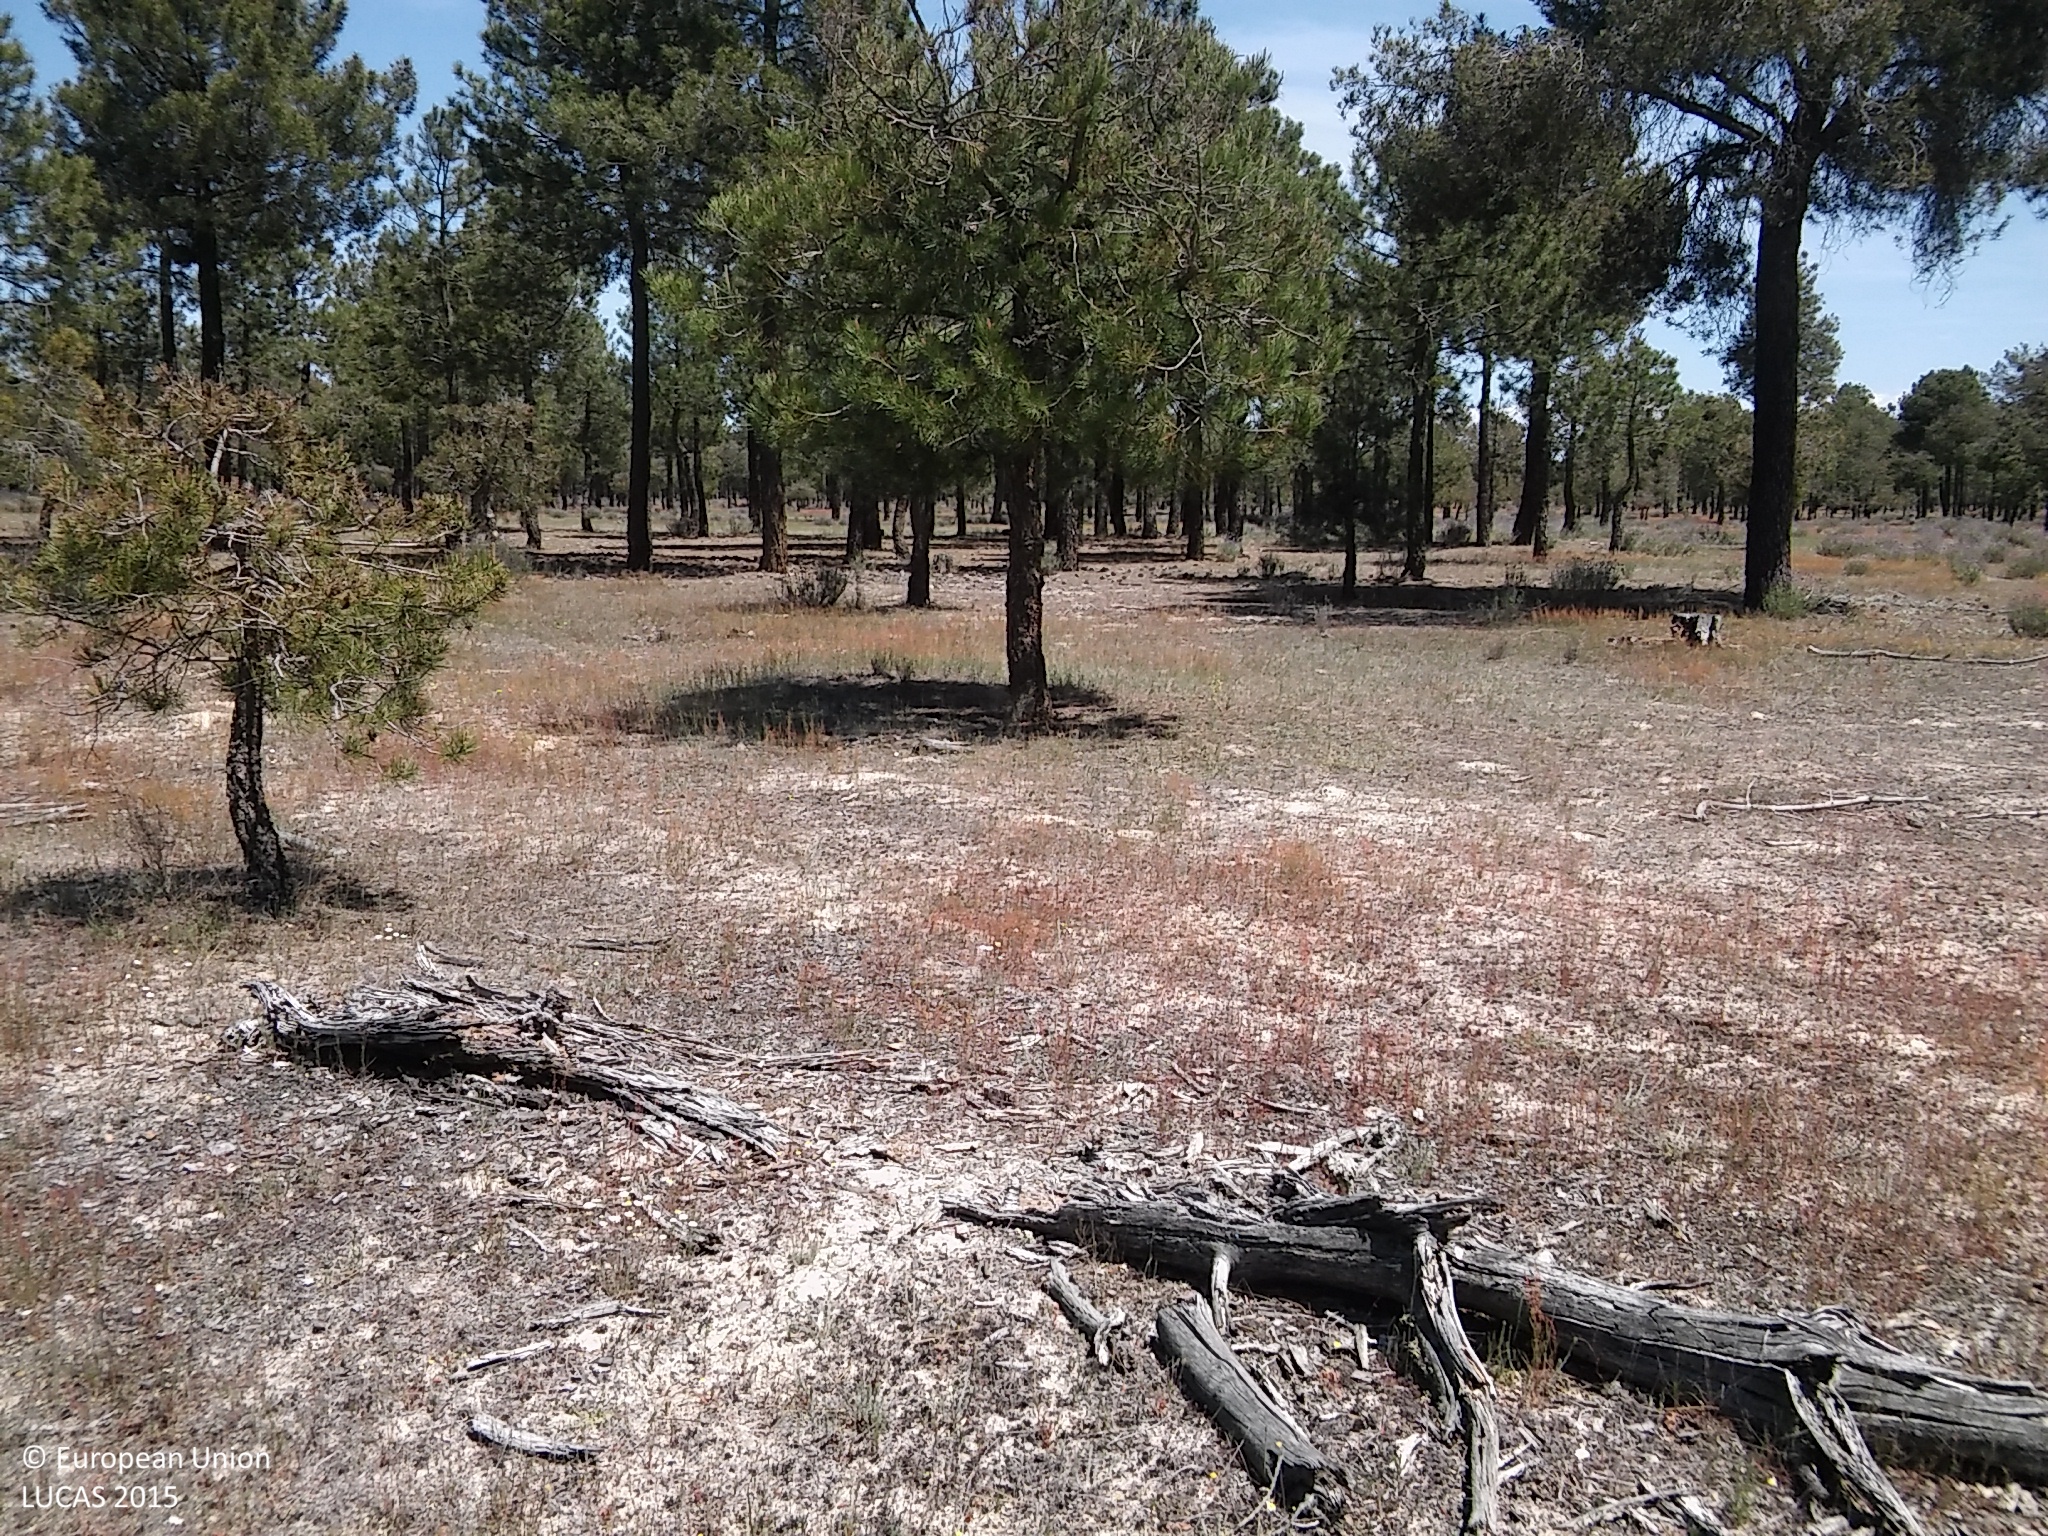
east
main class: Woodland
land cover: Pine dominated coniferous woodland
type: coniferous forest of the mediterranean region
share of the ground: 10 - 25 %
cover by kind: unconsolidated bare surface 65 %, coniferous forest trees 15 %, shrubs 10 %, lichens and mosses 10 %
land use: Forestry
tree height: > 5 m
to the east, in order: Pine dominated coniferous woodland
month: May
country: ES
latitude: 41.3178
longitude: -3.9456
